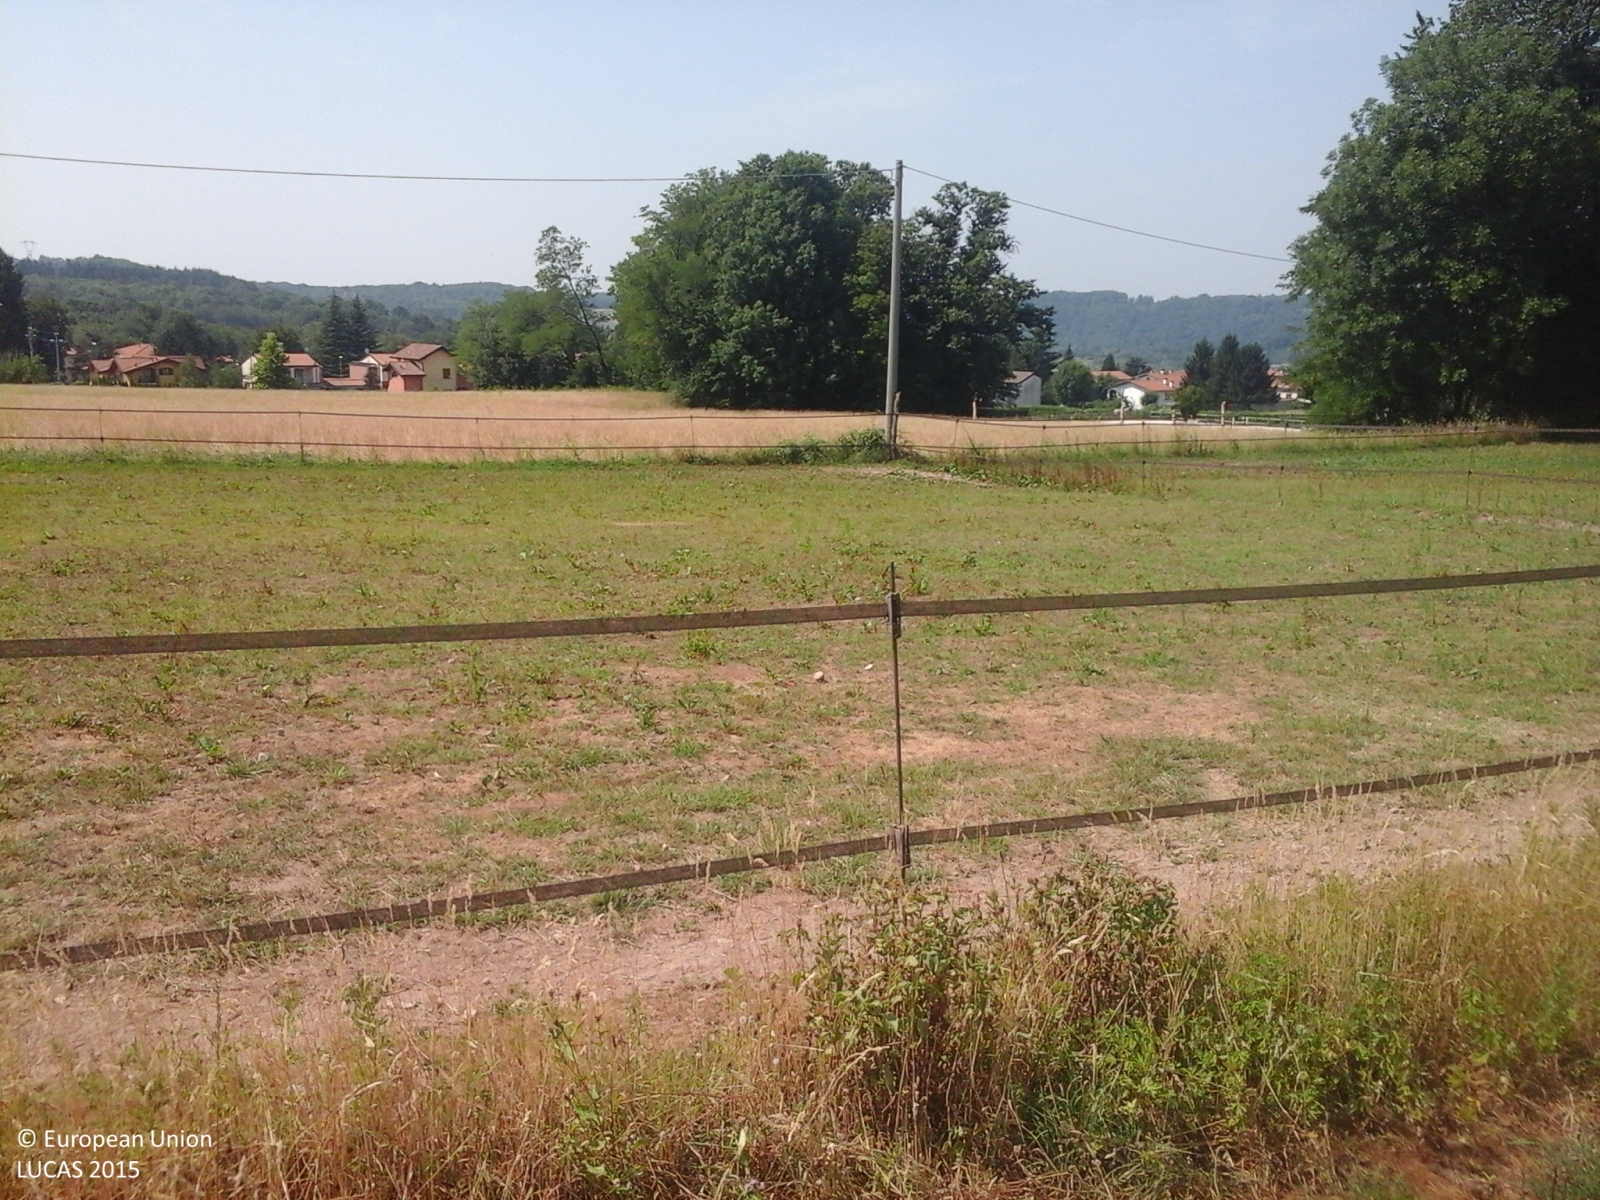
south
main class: Grassland
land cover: Grassland without tree/shrub cover
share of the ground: > 75 %
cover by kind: herbaceous plants 90 %, unconsolidated bare surface 10 %
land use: Agriculture (excluding fallow land and kitchen gardens)
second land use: Amenities, museums, leisure
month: July
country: IT
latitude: 45.8592
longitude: 8.9069
